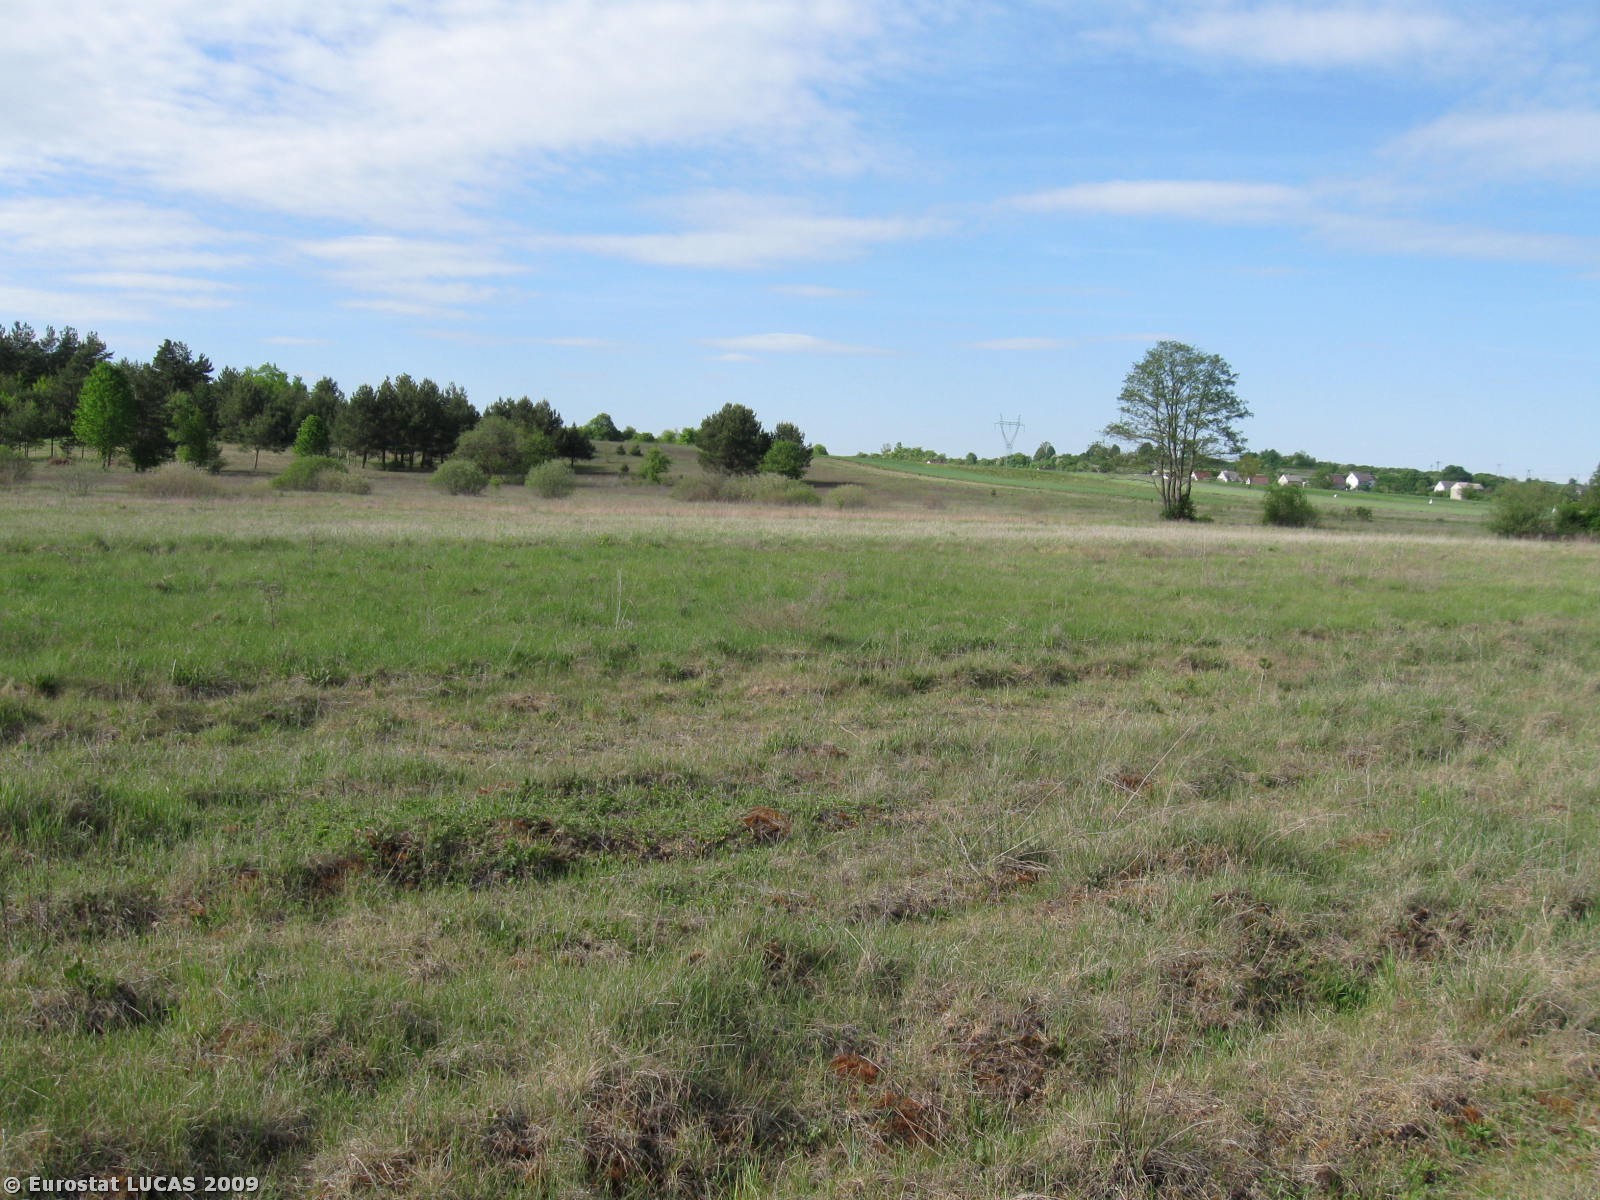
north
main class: Grassland
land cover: Grassland without tree/shrub cover
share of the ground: > 75 %
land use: Agriculture (excluding fallow land and kitchen gardens)
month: May
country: PL
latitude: 50.8504
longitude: 20.3917
